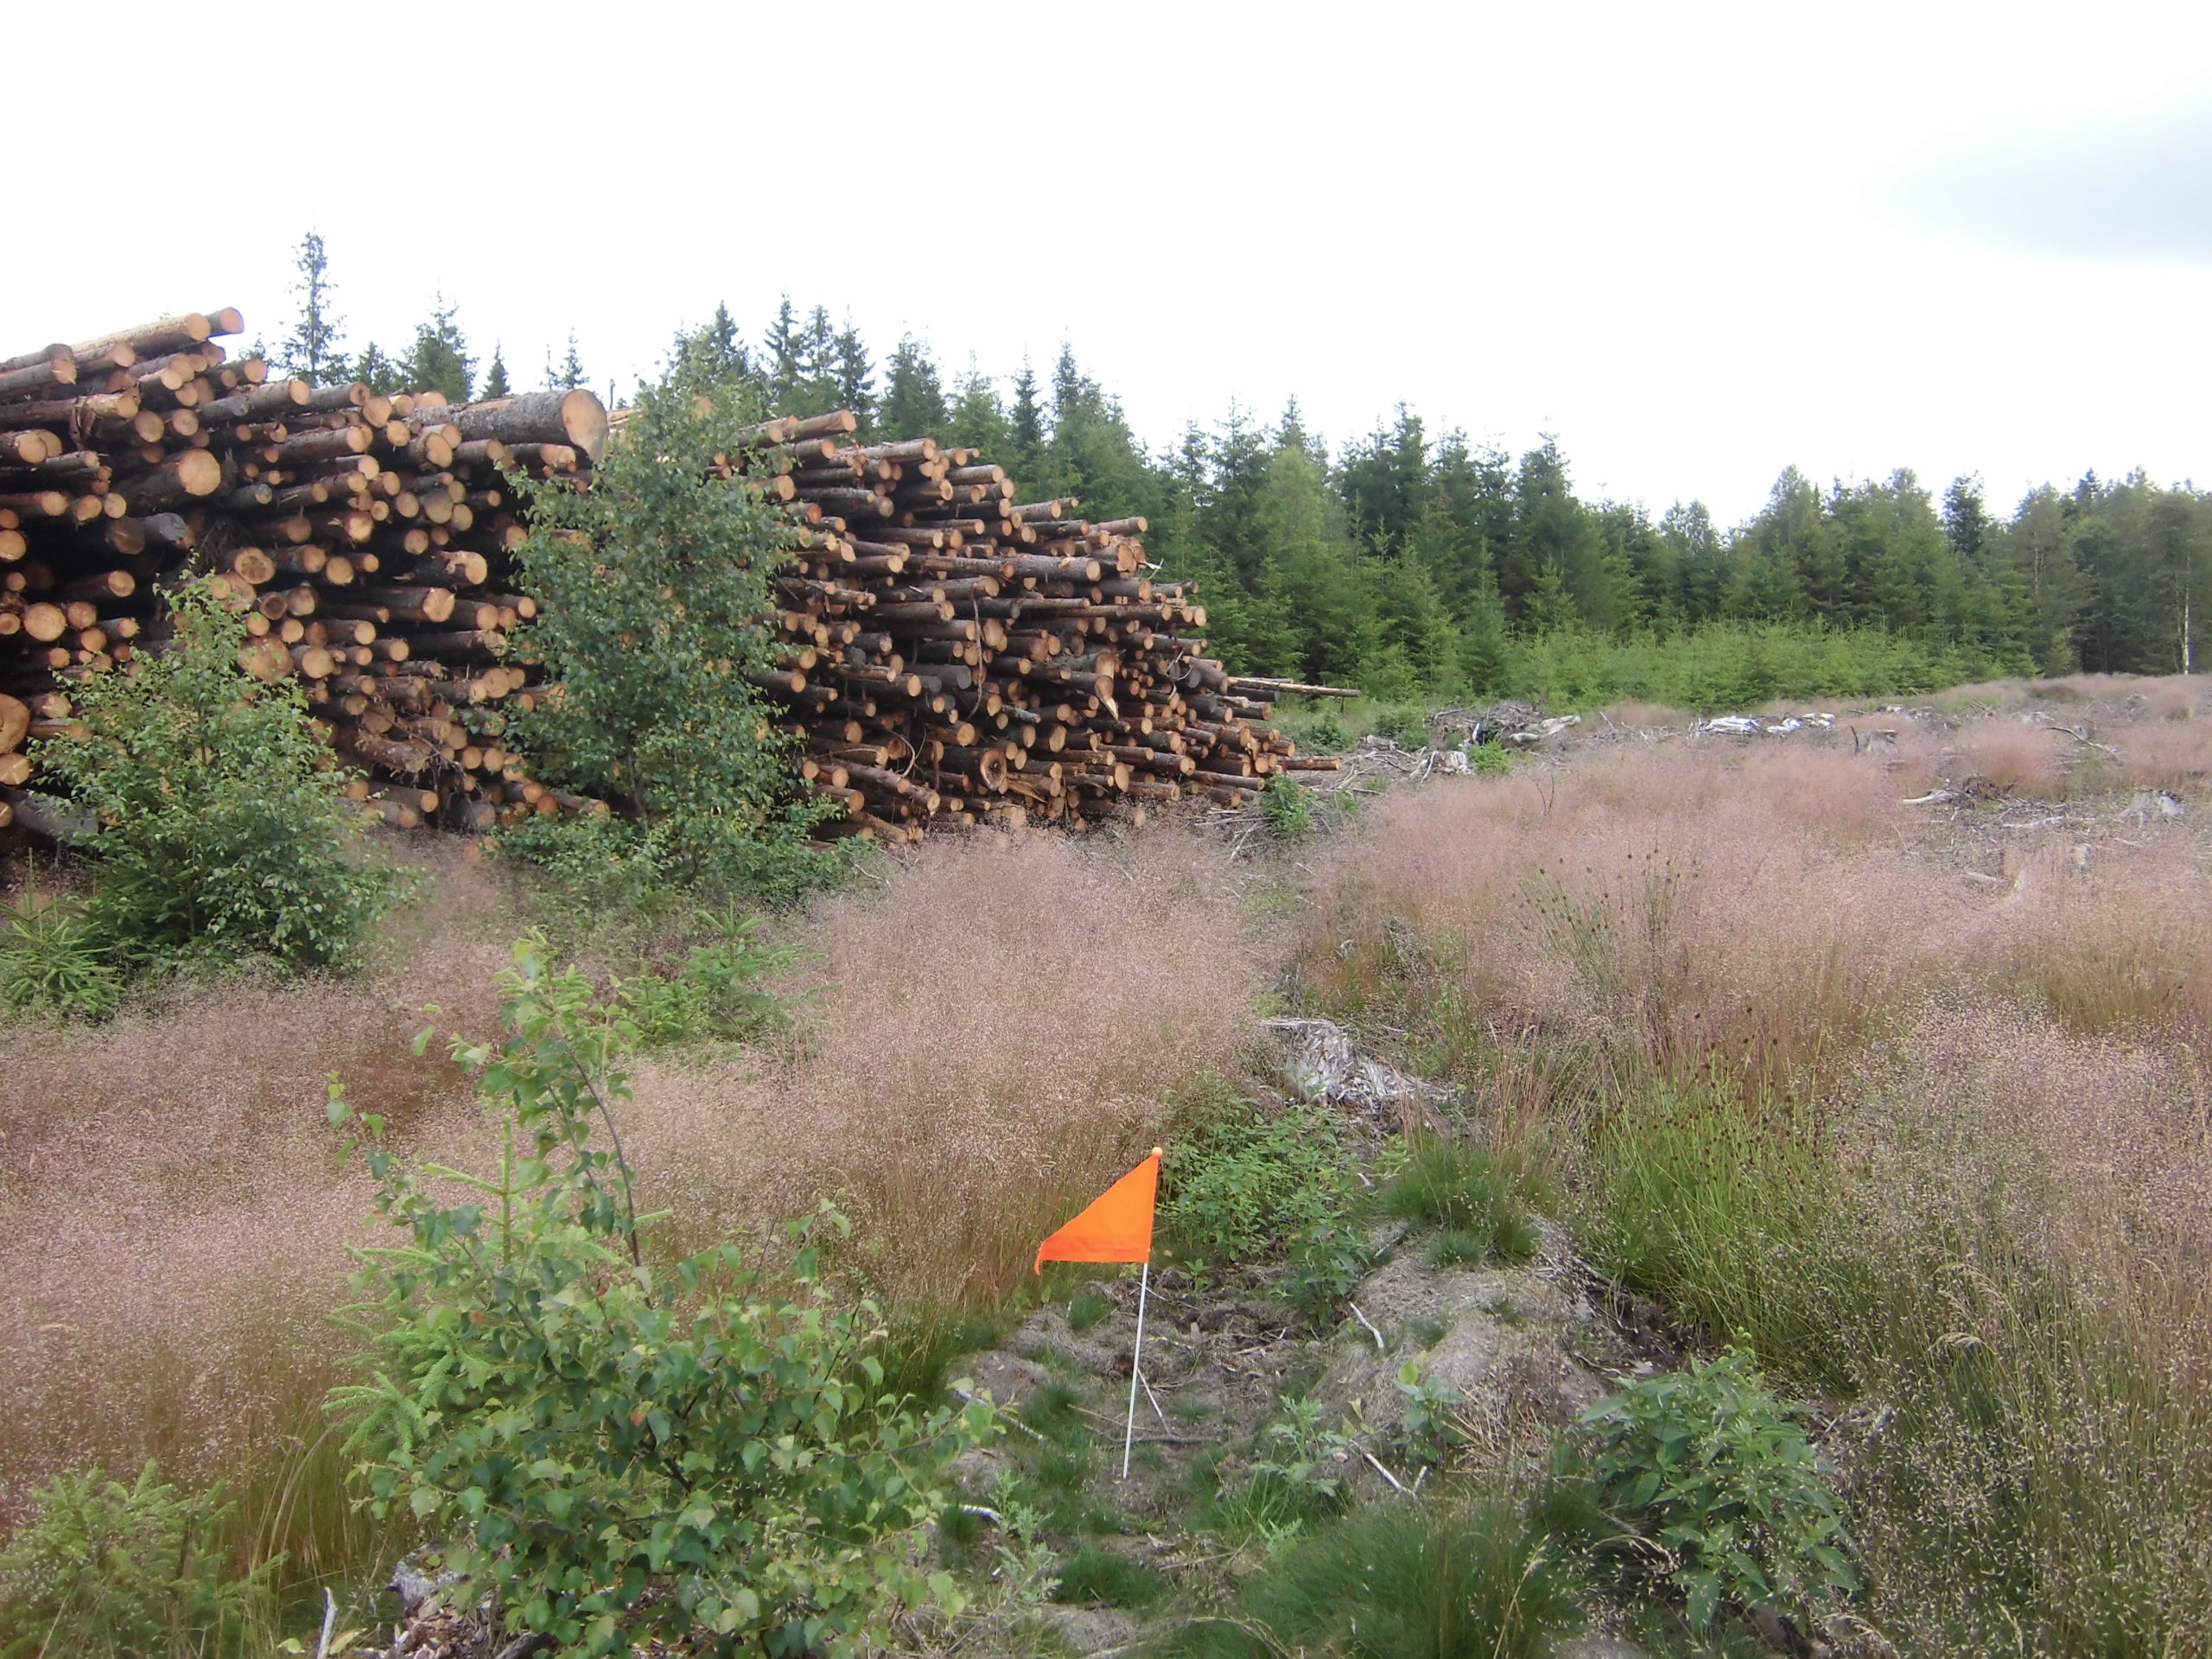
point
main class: Woodland
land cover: Spruce dominated mixed woodland
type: boreal forest
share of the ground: 25 - 50 %
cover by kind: herbaceous plants 45 %, broadleaved forest trees 15 %, coniferous forest trees 10 %, shrubs 10 %, lichens and mosses 10 %, unconsolidated bare surface 10 %
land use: Forestry
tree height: < 5 m
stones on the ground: 10 - 25 %
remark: Clear cut
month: July
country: SE
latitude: 57.4666
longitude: 14.8142
